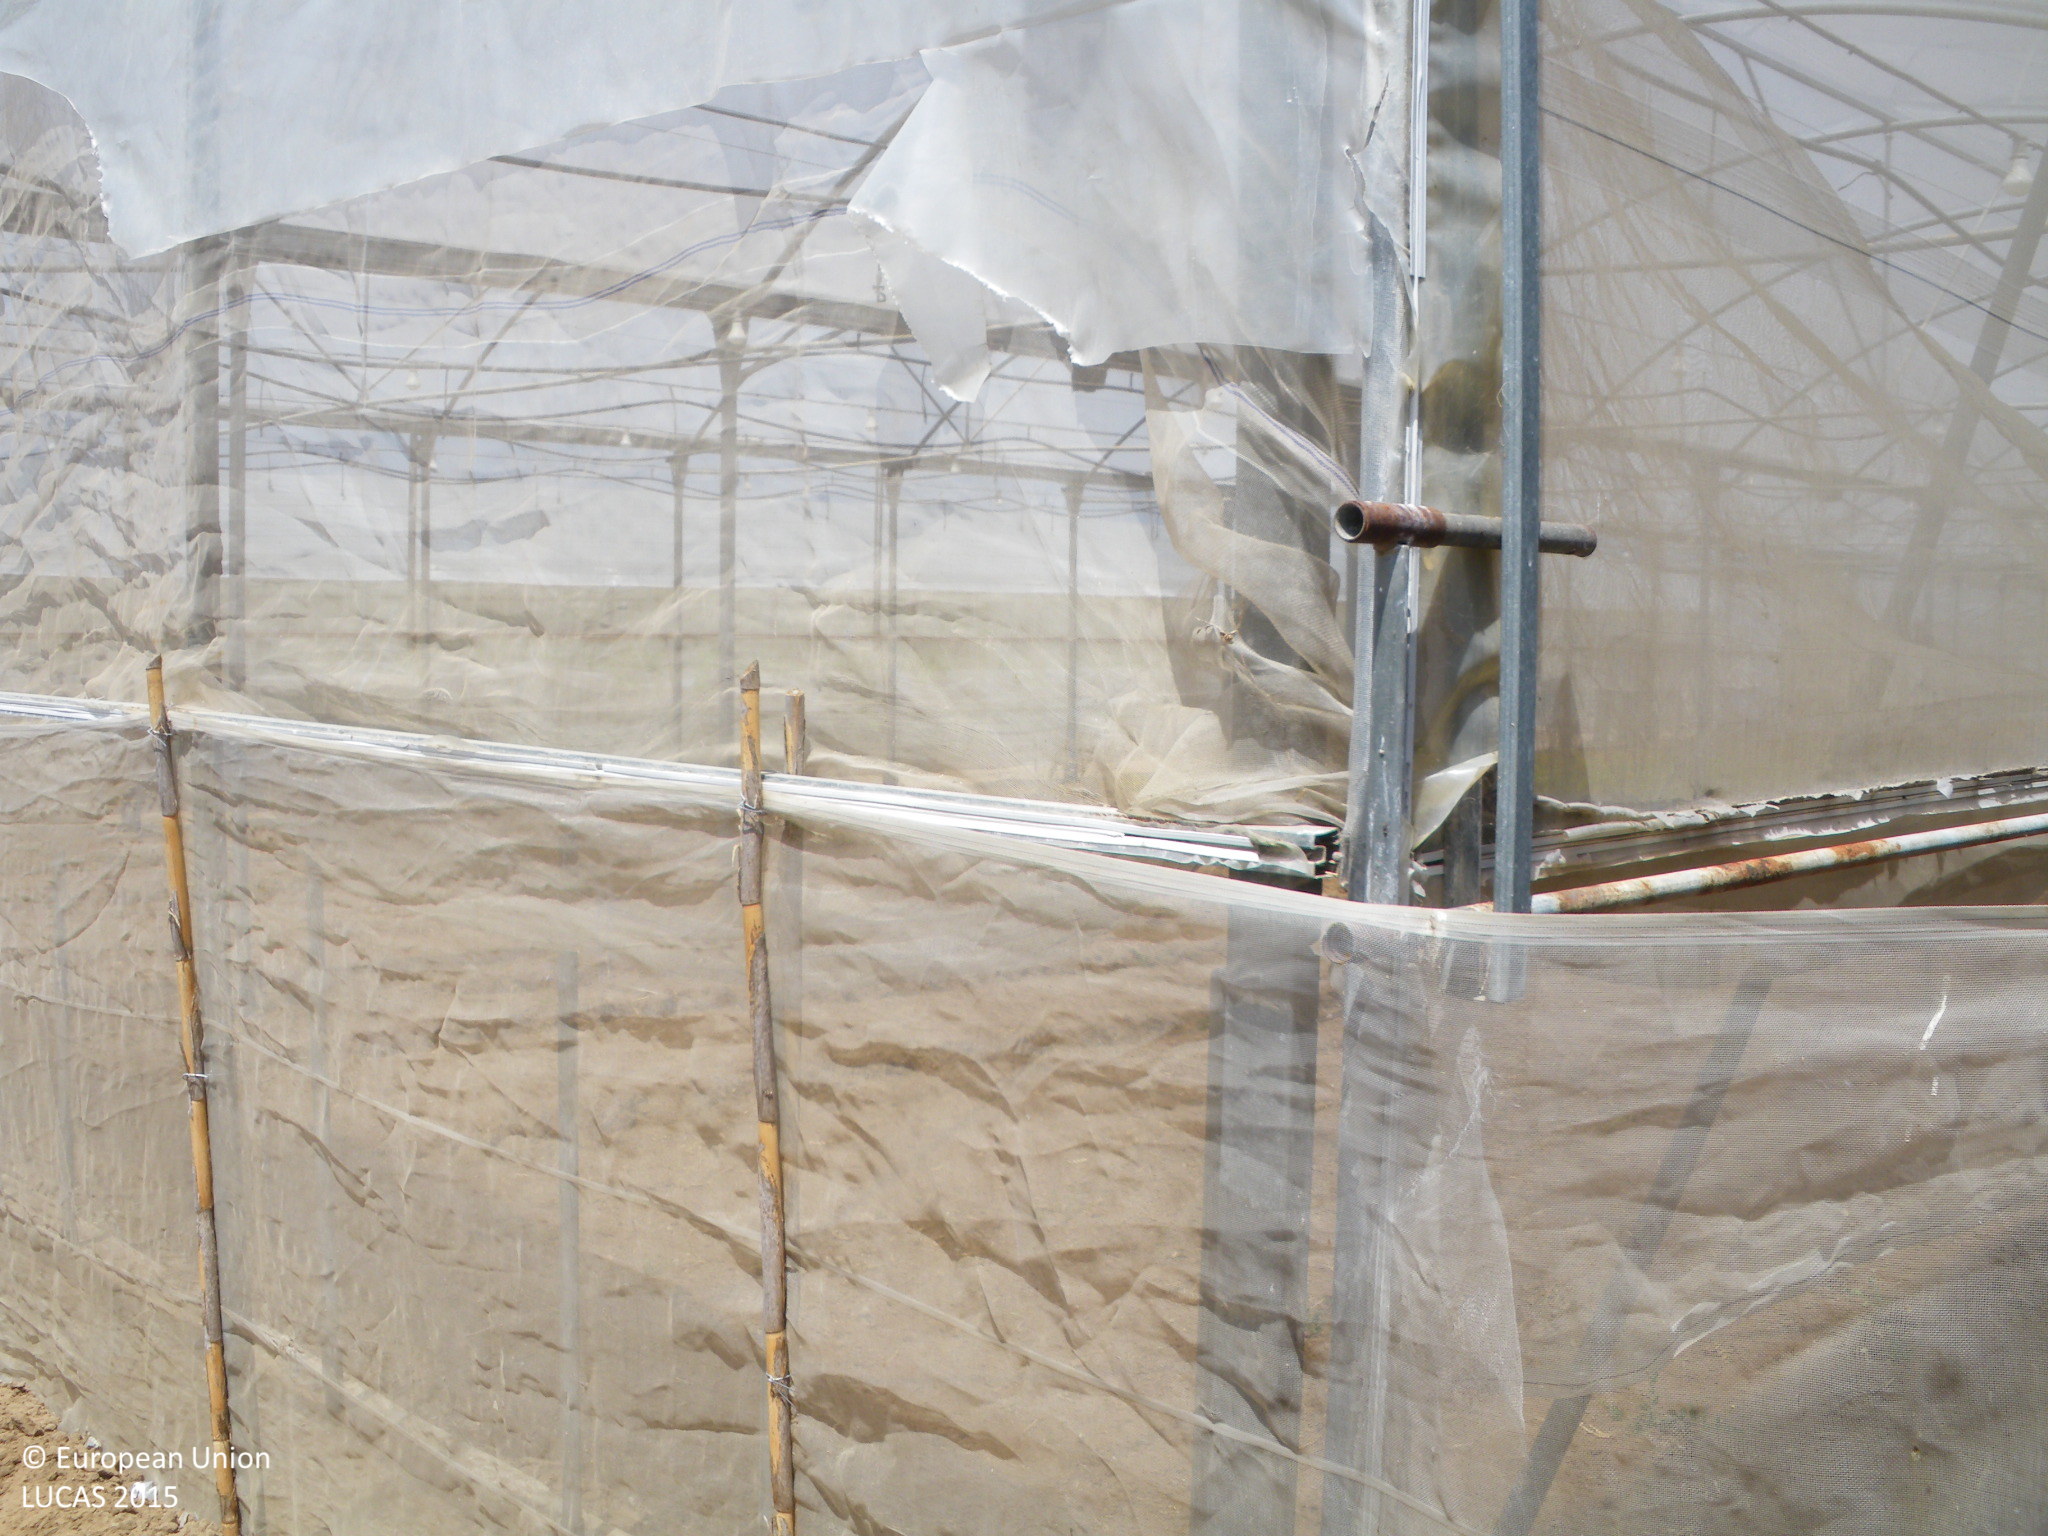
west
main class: Grassland
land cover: Grassland without tree/shrub cover
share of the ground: > 75 %
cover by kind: herbaceous plants 100 %
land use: Residential
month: June
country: ES
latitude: 36.7553
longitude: -6.4055
